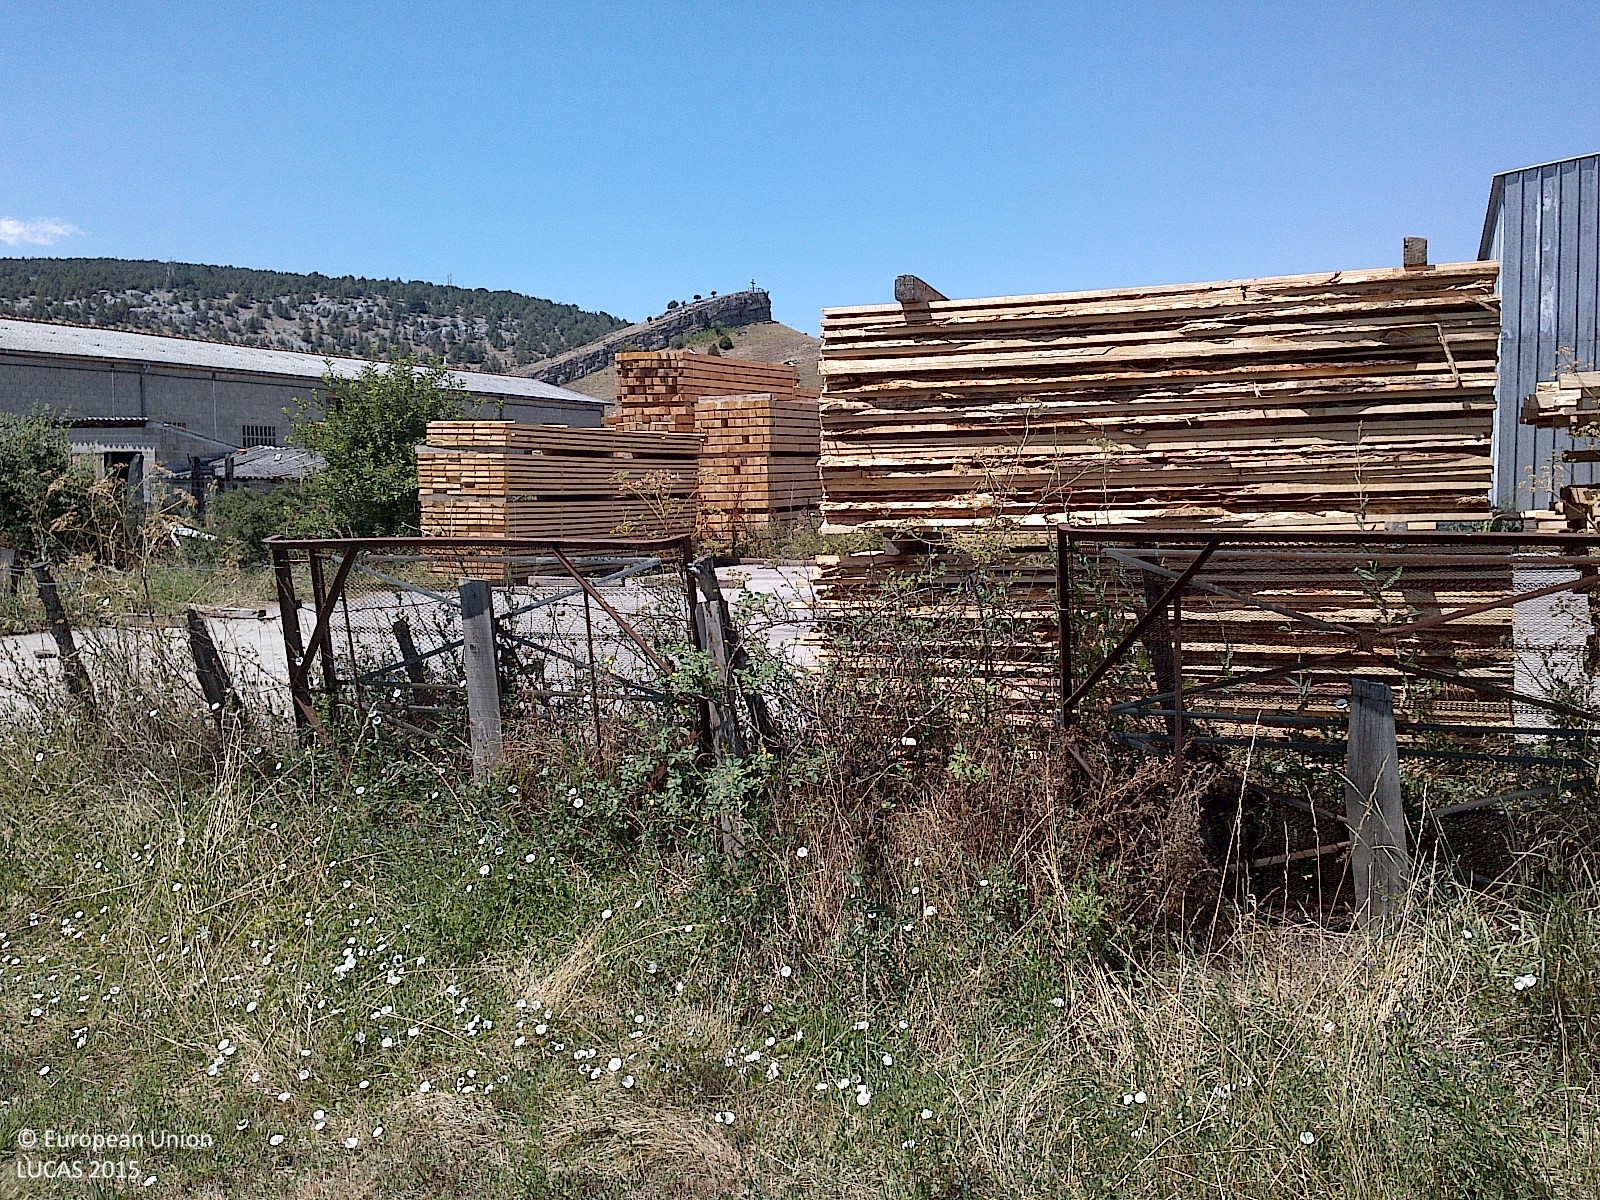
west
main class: Grassland
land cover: Grassland without tree/shrub cover
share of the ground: > 75 %
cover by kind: herbaceous plants 100 %
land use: Semi-natural and natural areas not in use
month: July
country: ES
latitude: 41.8456
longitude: -3.1631
